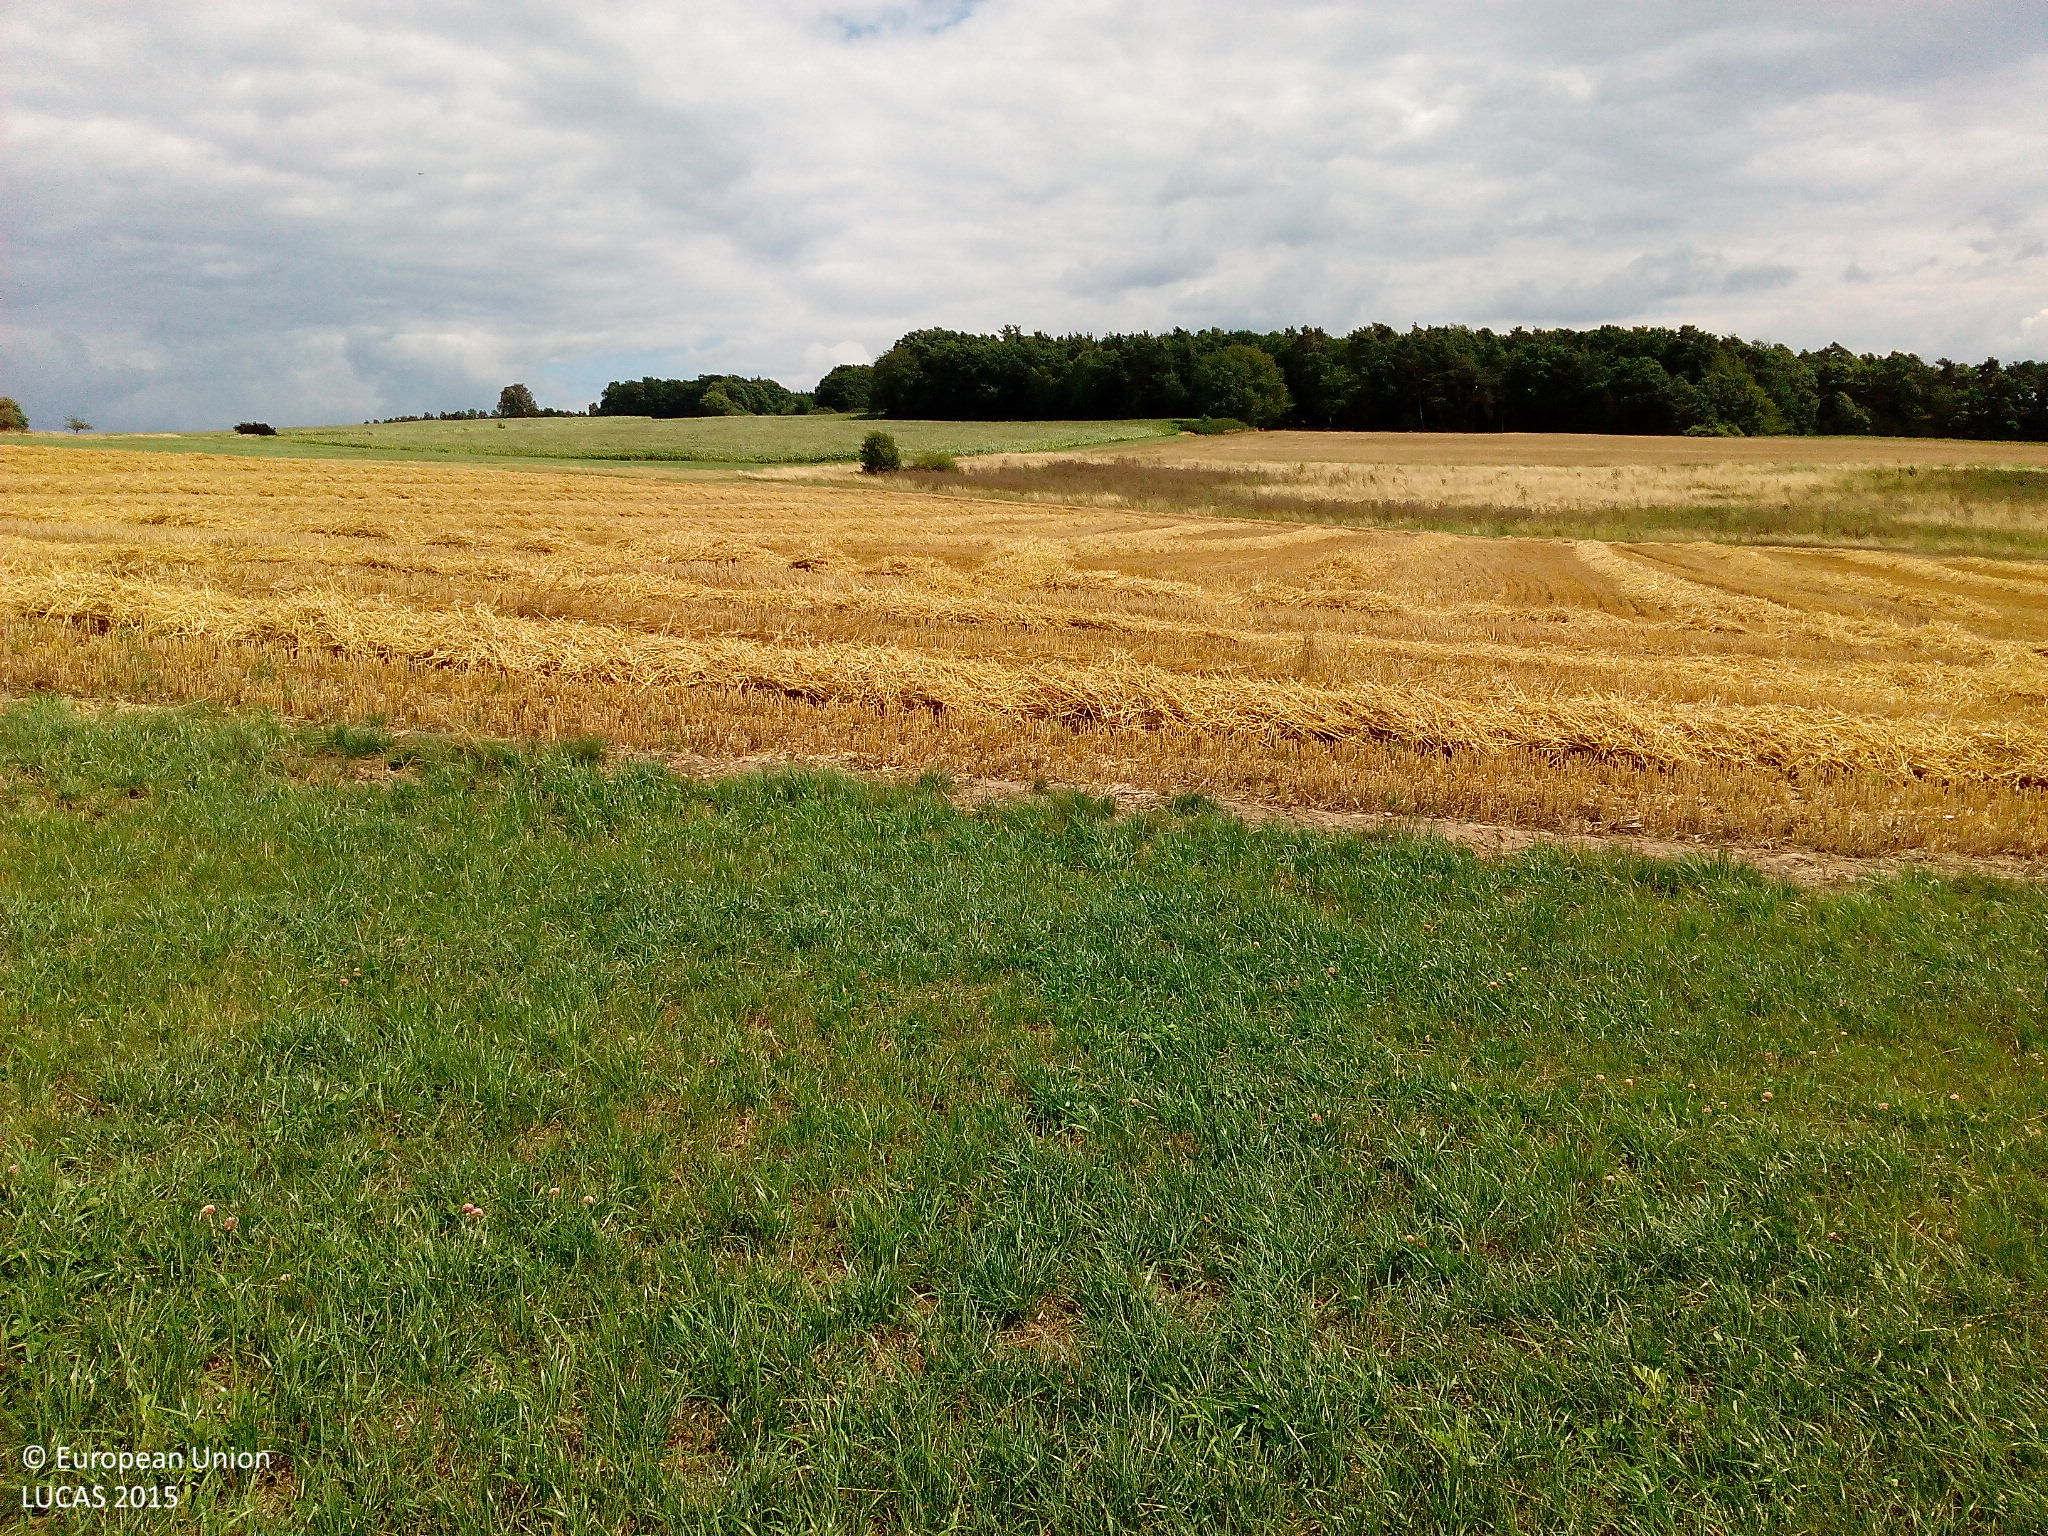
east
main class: Grassland
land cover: Grassland without tree/shrub cover
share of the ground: > 75 %
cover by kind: herbaceous plants 100 %
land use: Agriculture (excluding fallow land and kitchen gardens)
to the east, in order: Grassland without tree/shrub cover; Barley; Grass margins; Ditches and canals; Grassland with sparse tree/shrub cover; Tracks; Grassland without tree/shrub cover; Maize
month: July
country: DE
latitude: 50.5791
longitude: 9.5906
